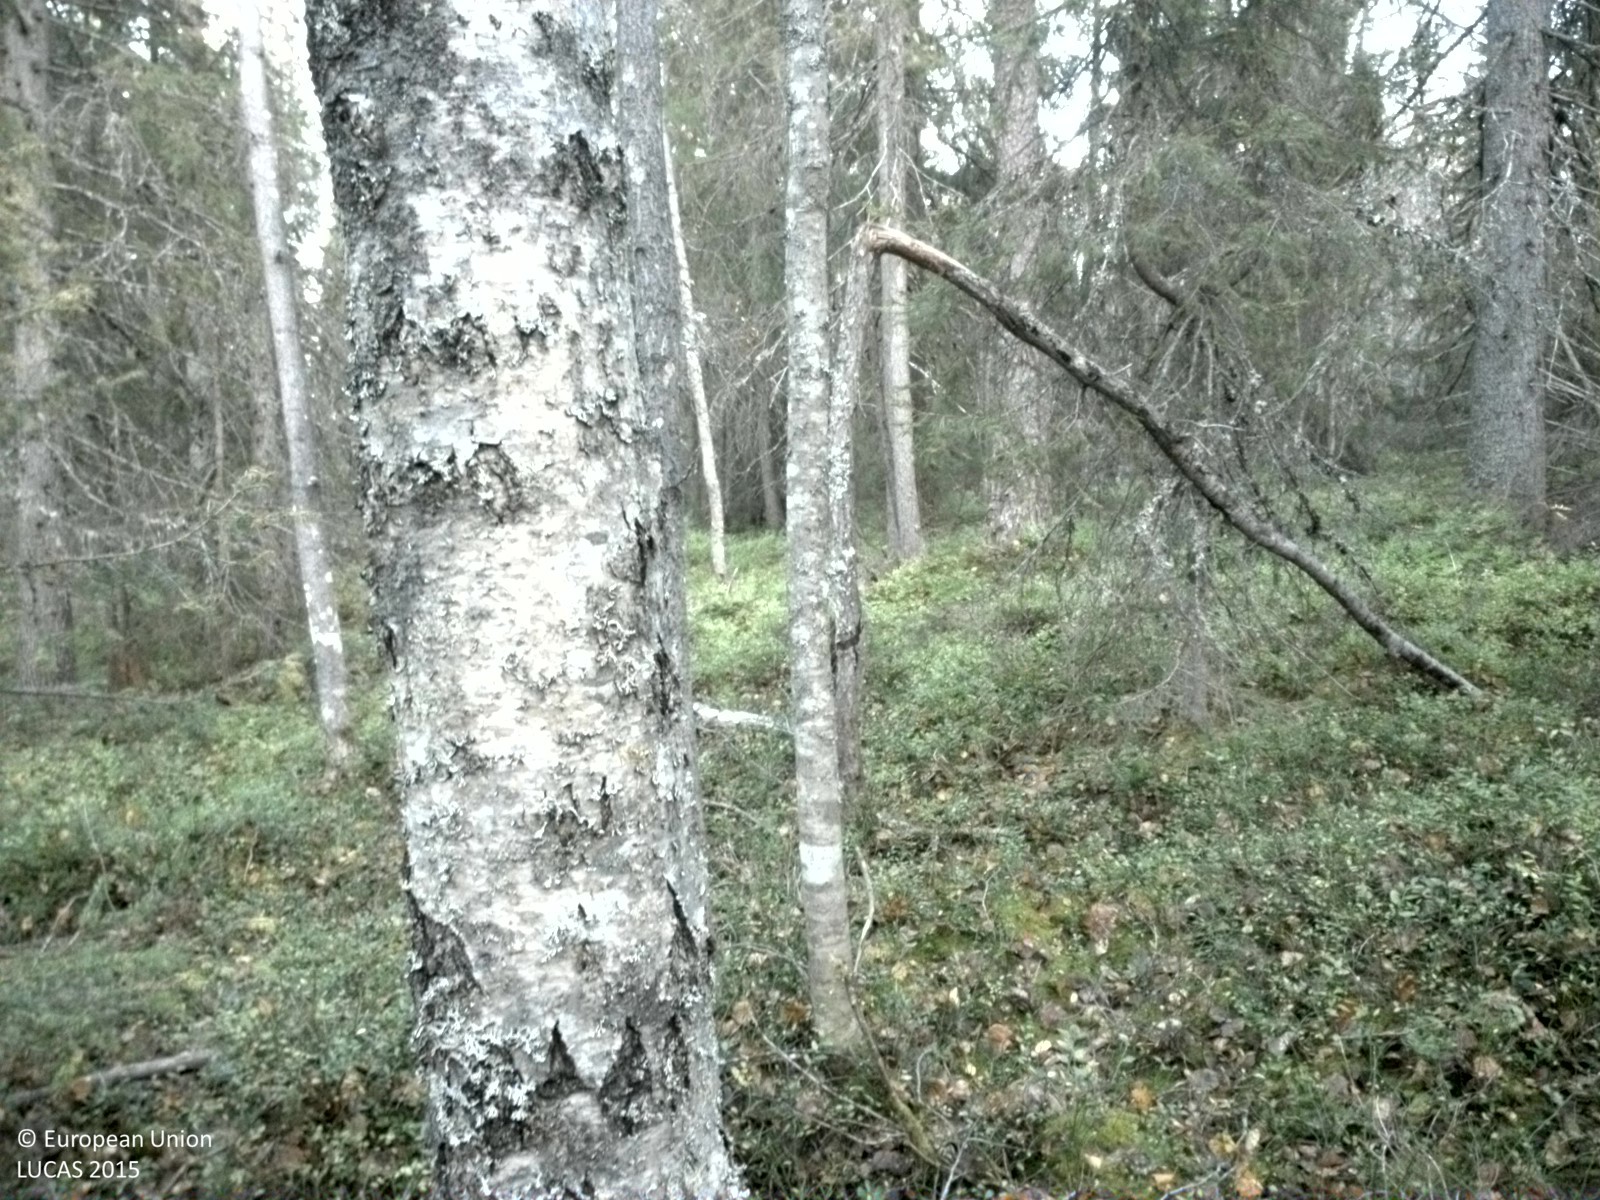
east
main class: Woodland
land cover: Spruce dominated mixed woodland
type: boreal forest
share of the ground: 50 - 75 %
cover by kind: shrubs 40 %, coniferous forest trees 35 %, broadleaved forest trees 25 %
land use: Amenities, museums, leisure
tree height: > 5 m
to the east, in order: Spruce dominated mixed woodland; Spruce dominated coniferous woodland
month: October
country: SE
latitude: 65.5923
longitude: 21.9710
